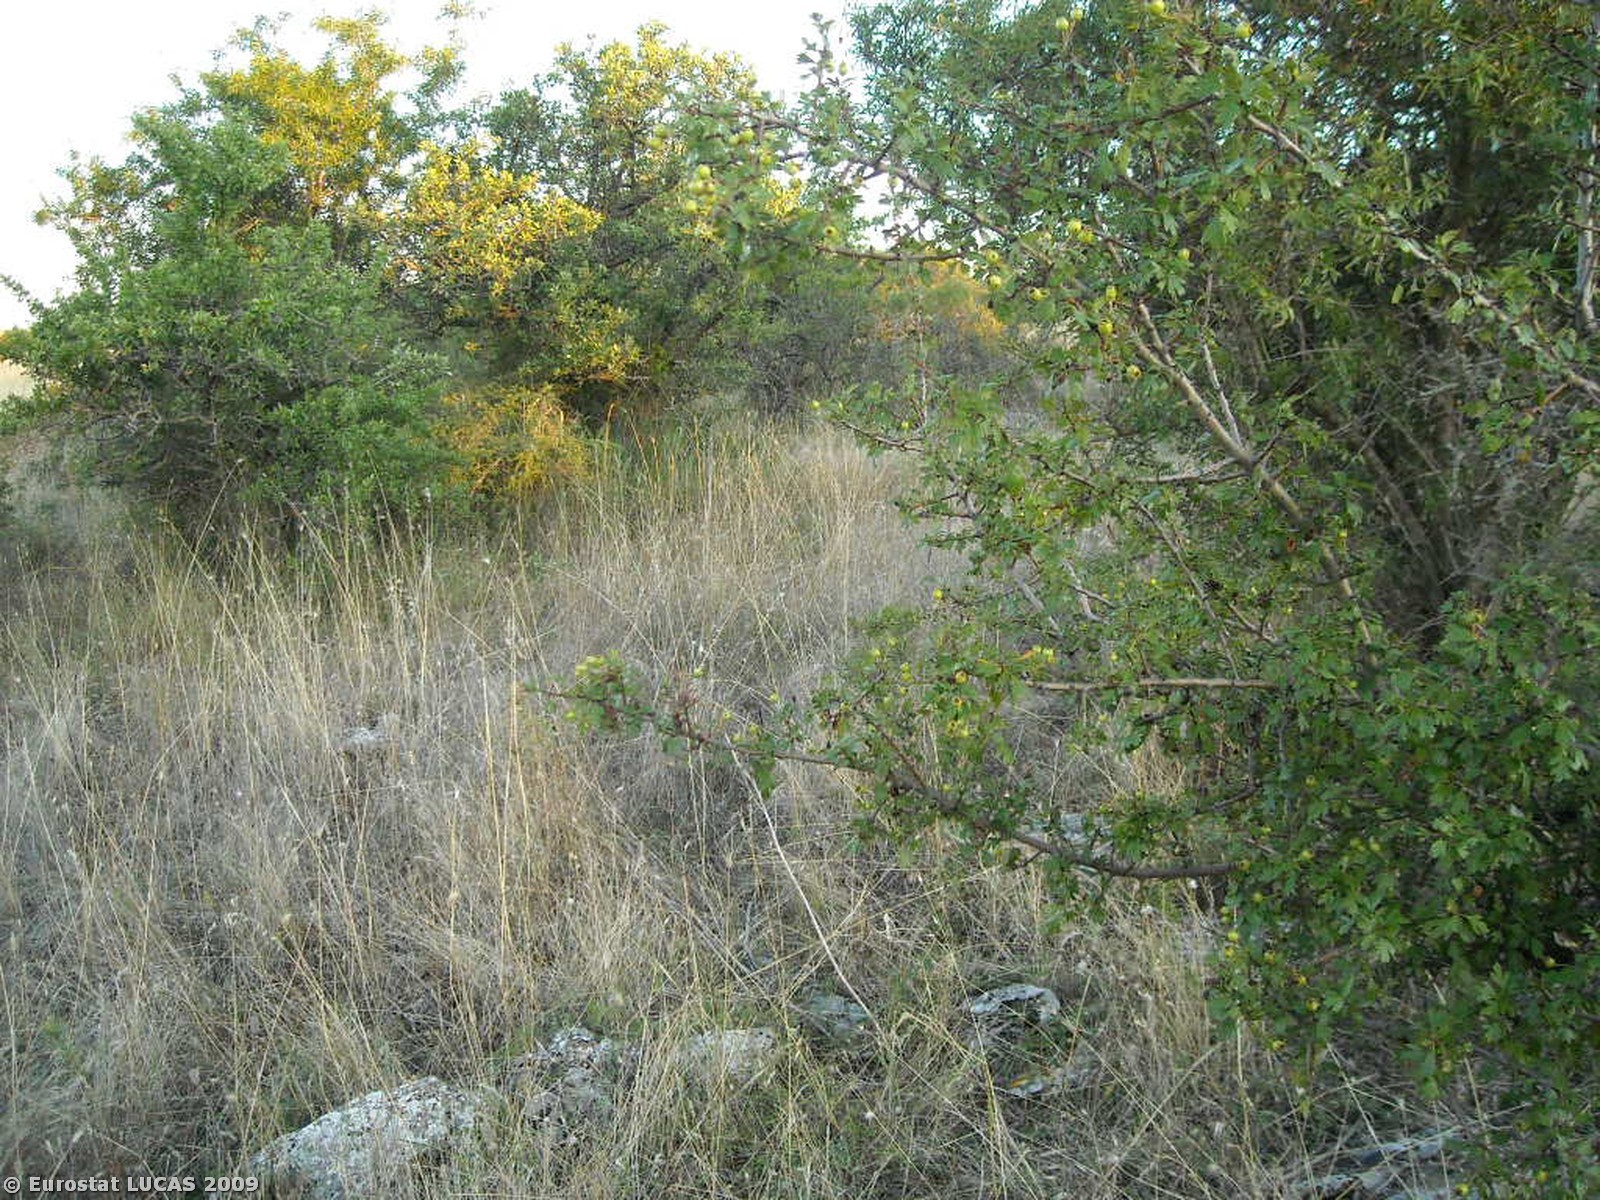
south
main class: Shrubland
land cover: Shrubland with sparse tree cover
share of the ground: > 75 %
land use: Fallow land
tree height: < 5 m
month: July
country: IT
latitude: 41.0596
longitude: 16.3453
